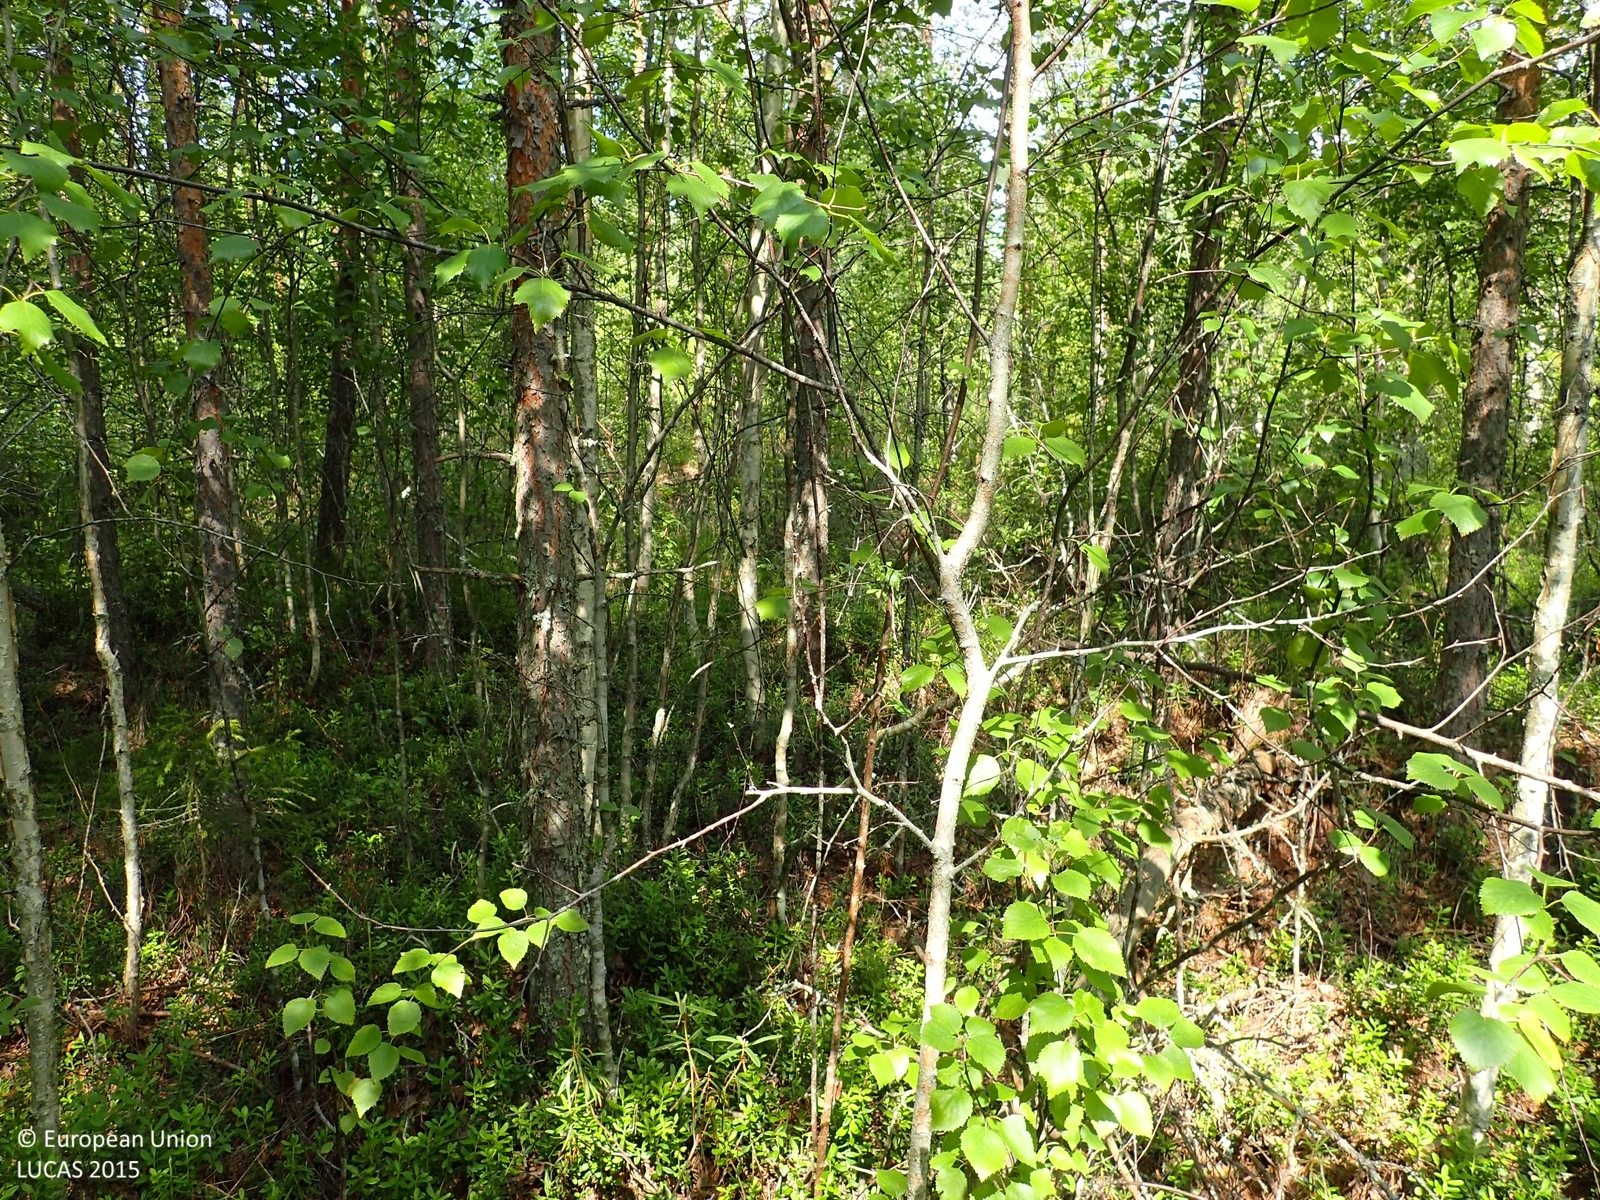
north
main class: Woodland
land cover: Pine dominated coniferous woodland
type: boreal forest
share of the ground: > 75 %
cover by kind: coniferous forest trees 70 %, shrubs 20 %, broadleaved forest trees 10 %
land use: Forestry
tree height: > 5 m
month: July
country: FI
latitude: 62.7056
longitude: 23.6175
